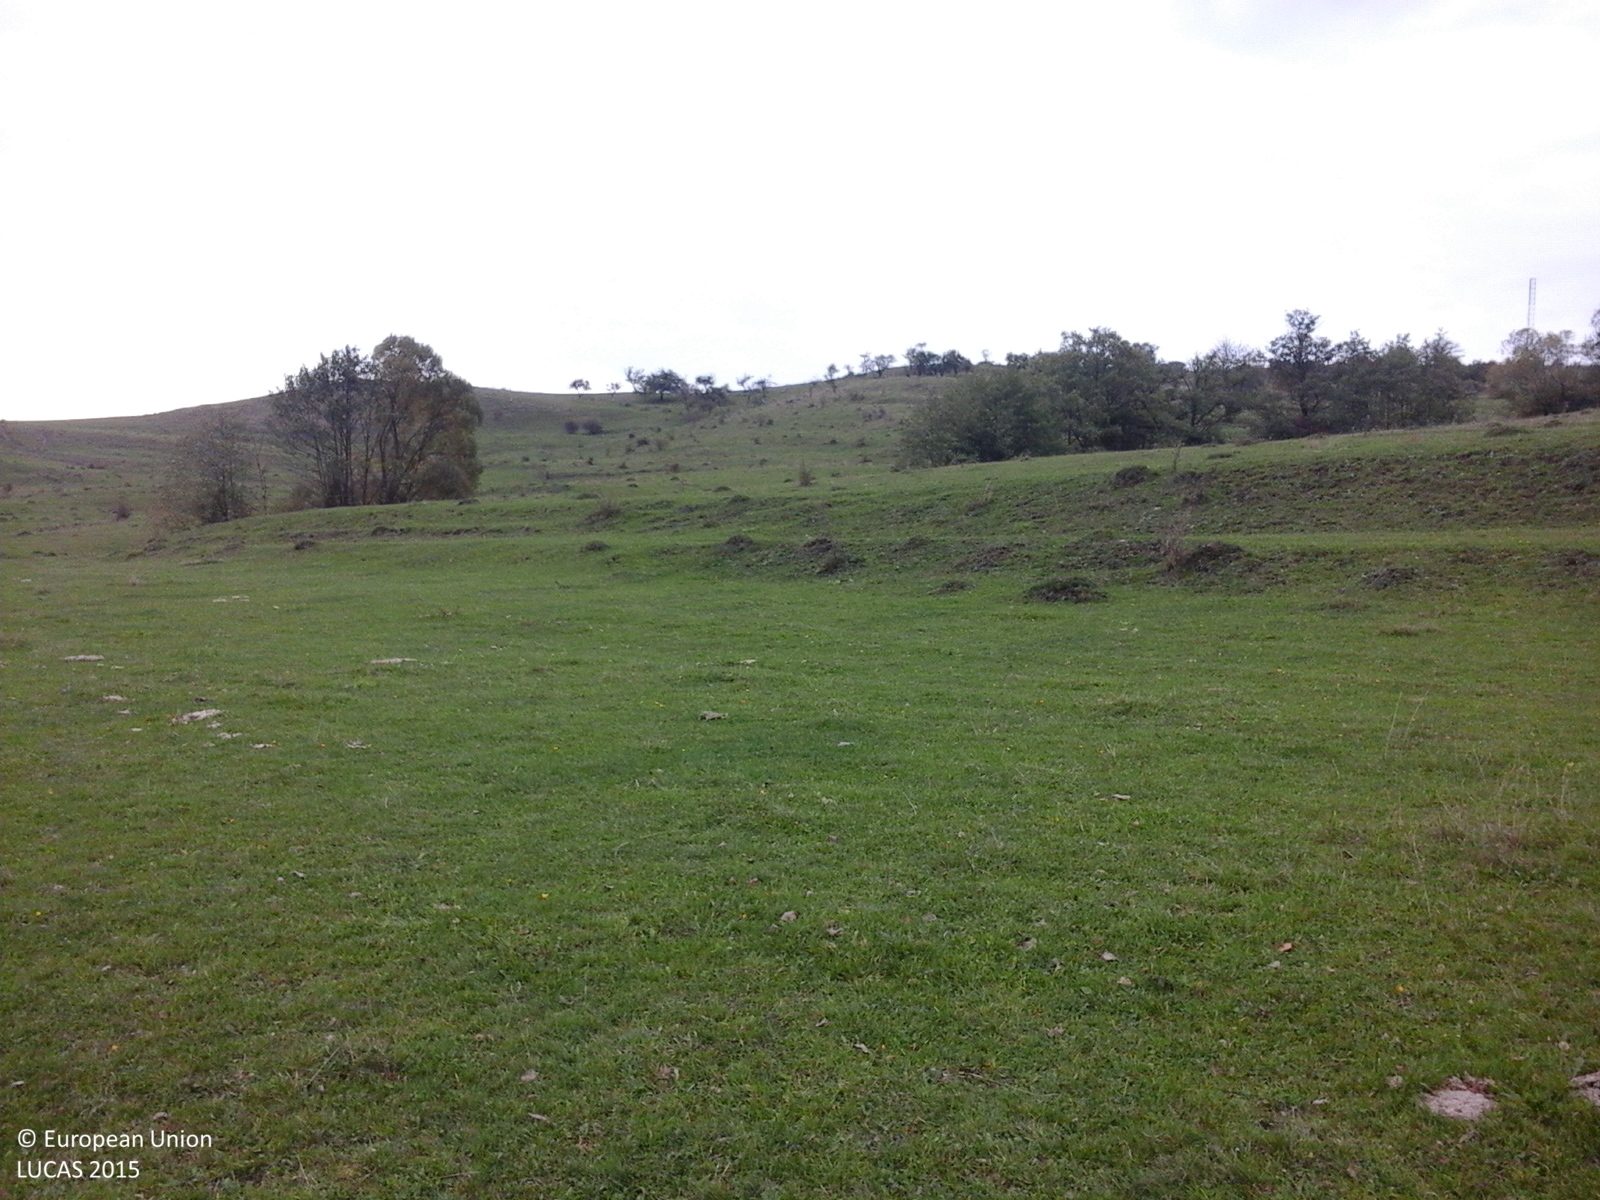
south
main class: Grassland
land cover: Grassland without tree/shrub cover
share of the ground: > 75 %
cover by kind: herbaceous plants 100 %
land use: Agriculture (excluding fallow land and kitchen gardens)
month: October
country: RO
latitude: 46.3859
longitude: 25.1178
